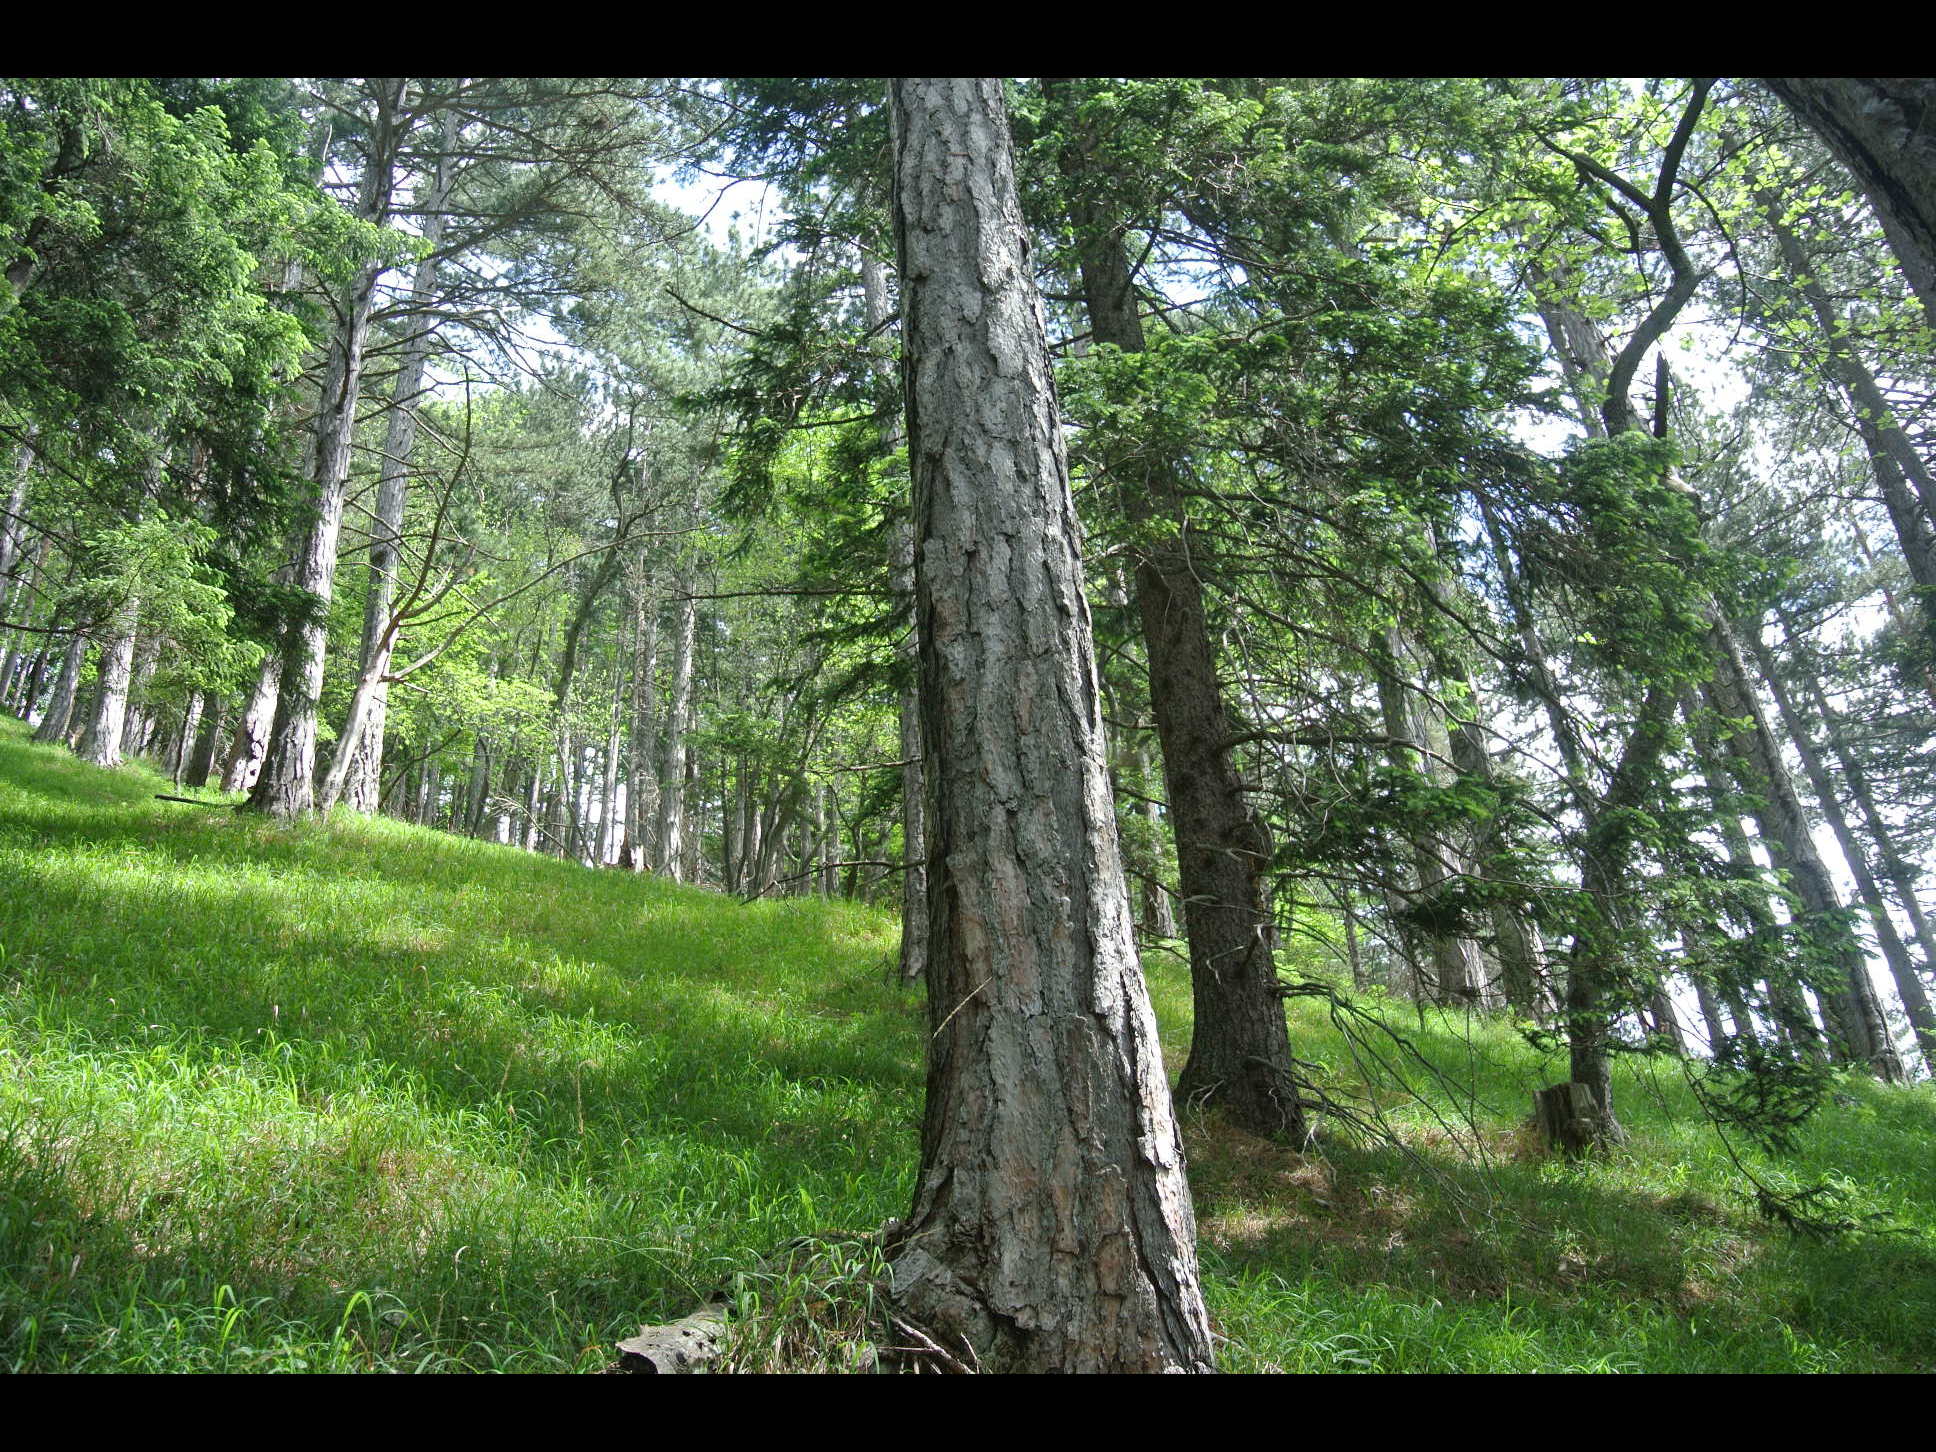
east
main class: Woodland
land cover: Other mixed woodland
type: alpine coniferous forest
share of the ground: > 75 %
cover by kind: coniferous forest trees 55 %, broadleaved forest trees 25 %, herbaceous plants 20 %
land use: Forestry
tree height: > 5 m
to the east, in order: Other mixed woodland; Broadleaved woodland; Pine dominated coniferous woodland; Spontaneously vegetated surfaces
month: May
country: AT
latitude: 47.9611
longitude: 15.8285
